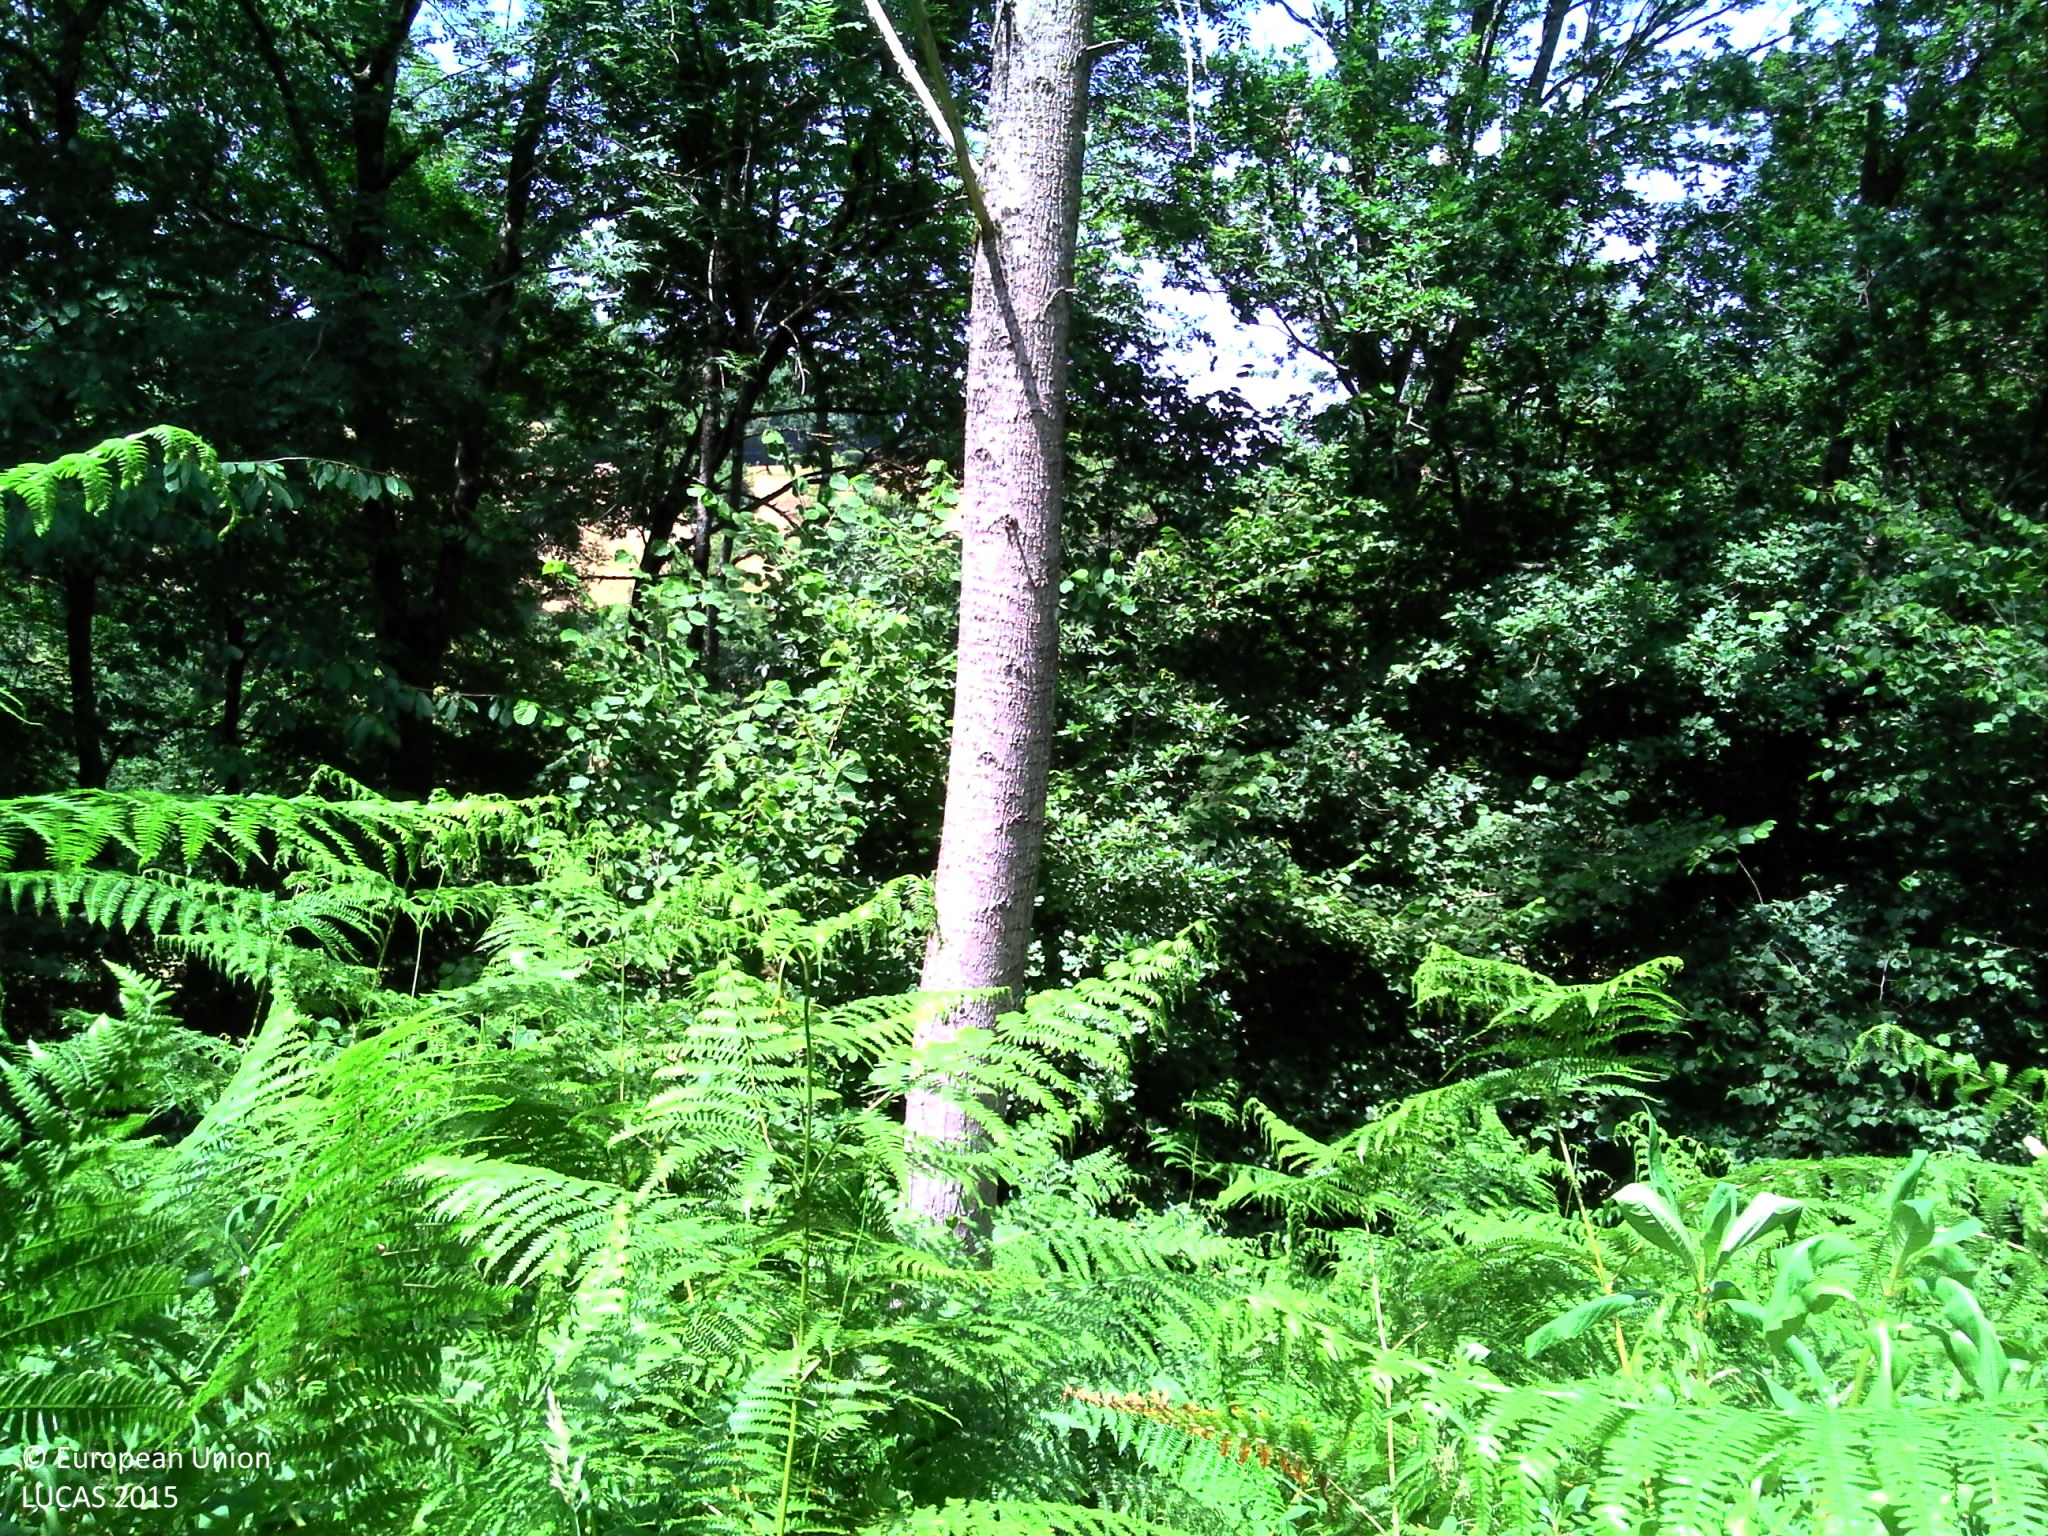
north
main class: Shrubland
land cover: Shrubland without tree cover
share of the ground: > 75 %
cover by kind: shrubs 40 %, herbaceous plants 30 %, lichens and mosses 30 %
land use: Semi-natural and natural areas not in use
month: July
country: FR
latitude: 43.0053
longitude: 0.8884
